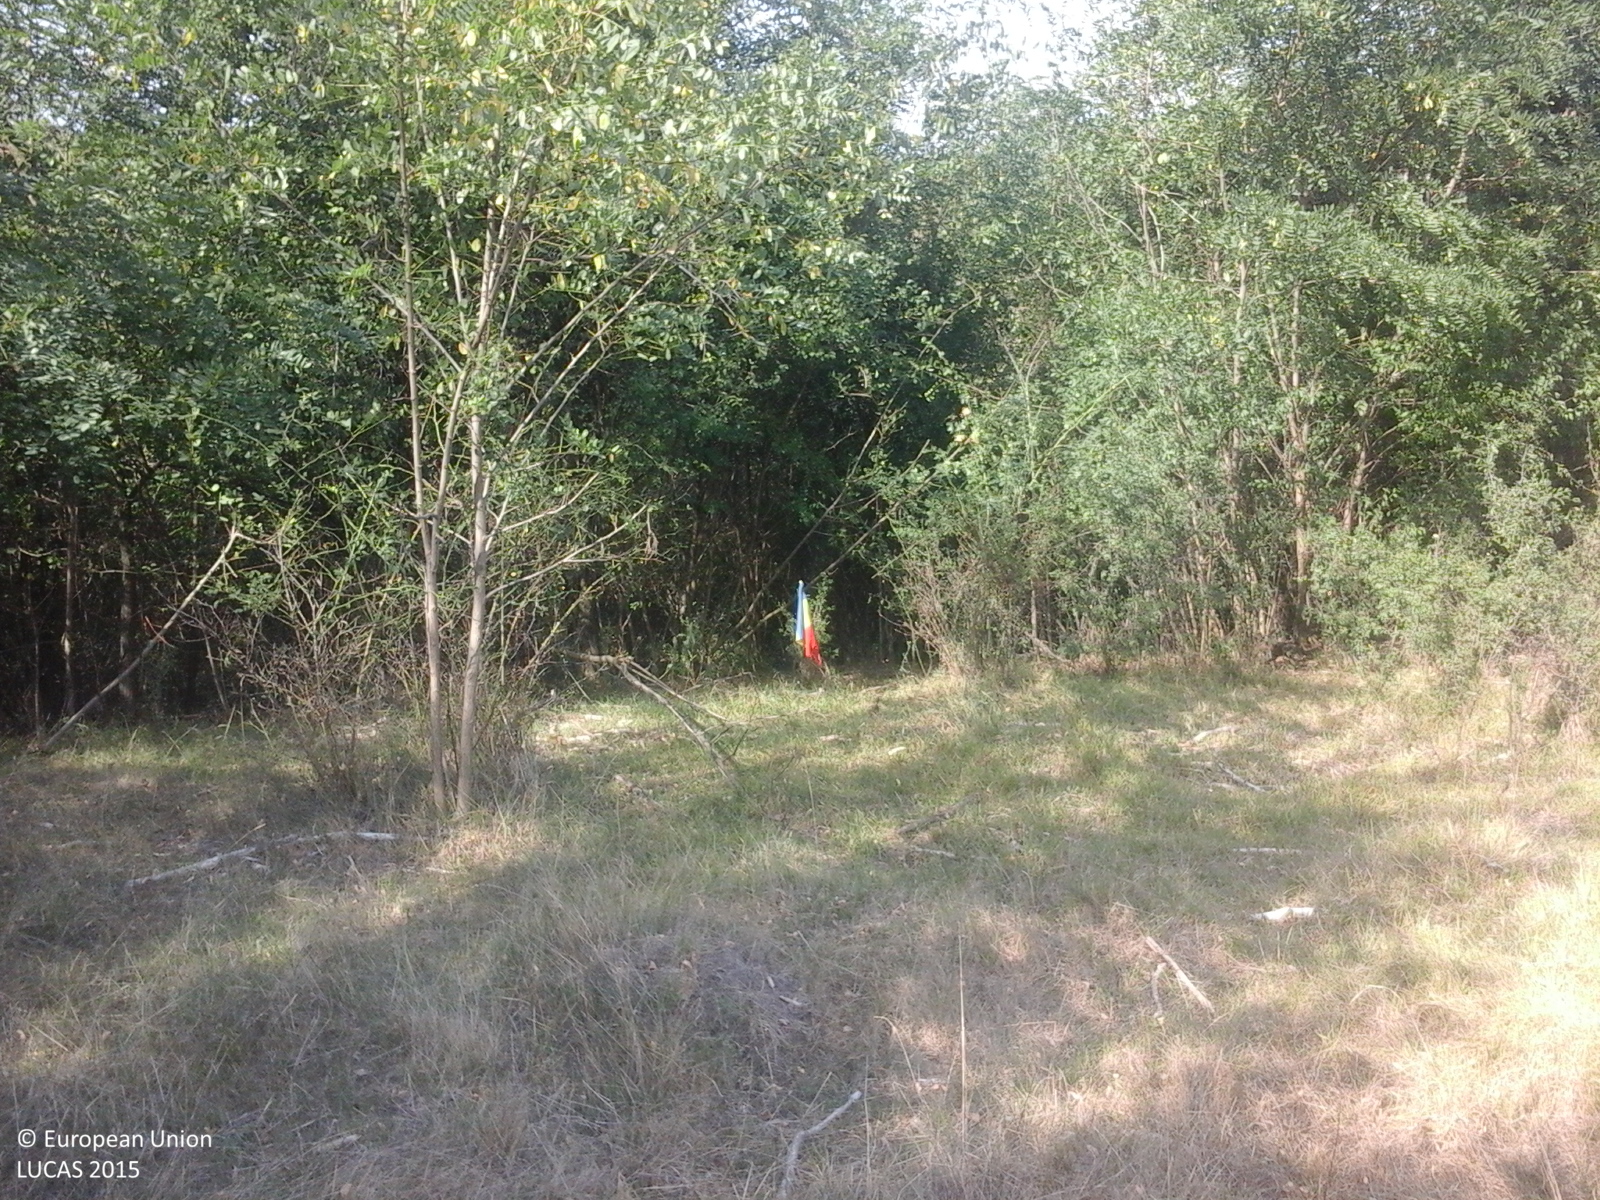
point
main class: Woodland
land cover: Broadleaved woodland
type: exotic forest
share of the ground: > 75 %
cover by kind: broadleaved forest trees 100 %
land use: Forestry
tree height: > 5 m
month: September
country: RO
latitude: 47.4168
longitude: 23.1222
